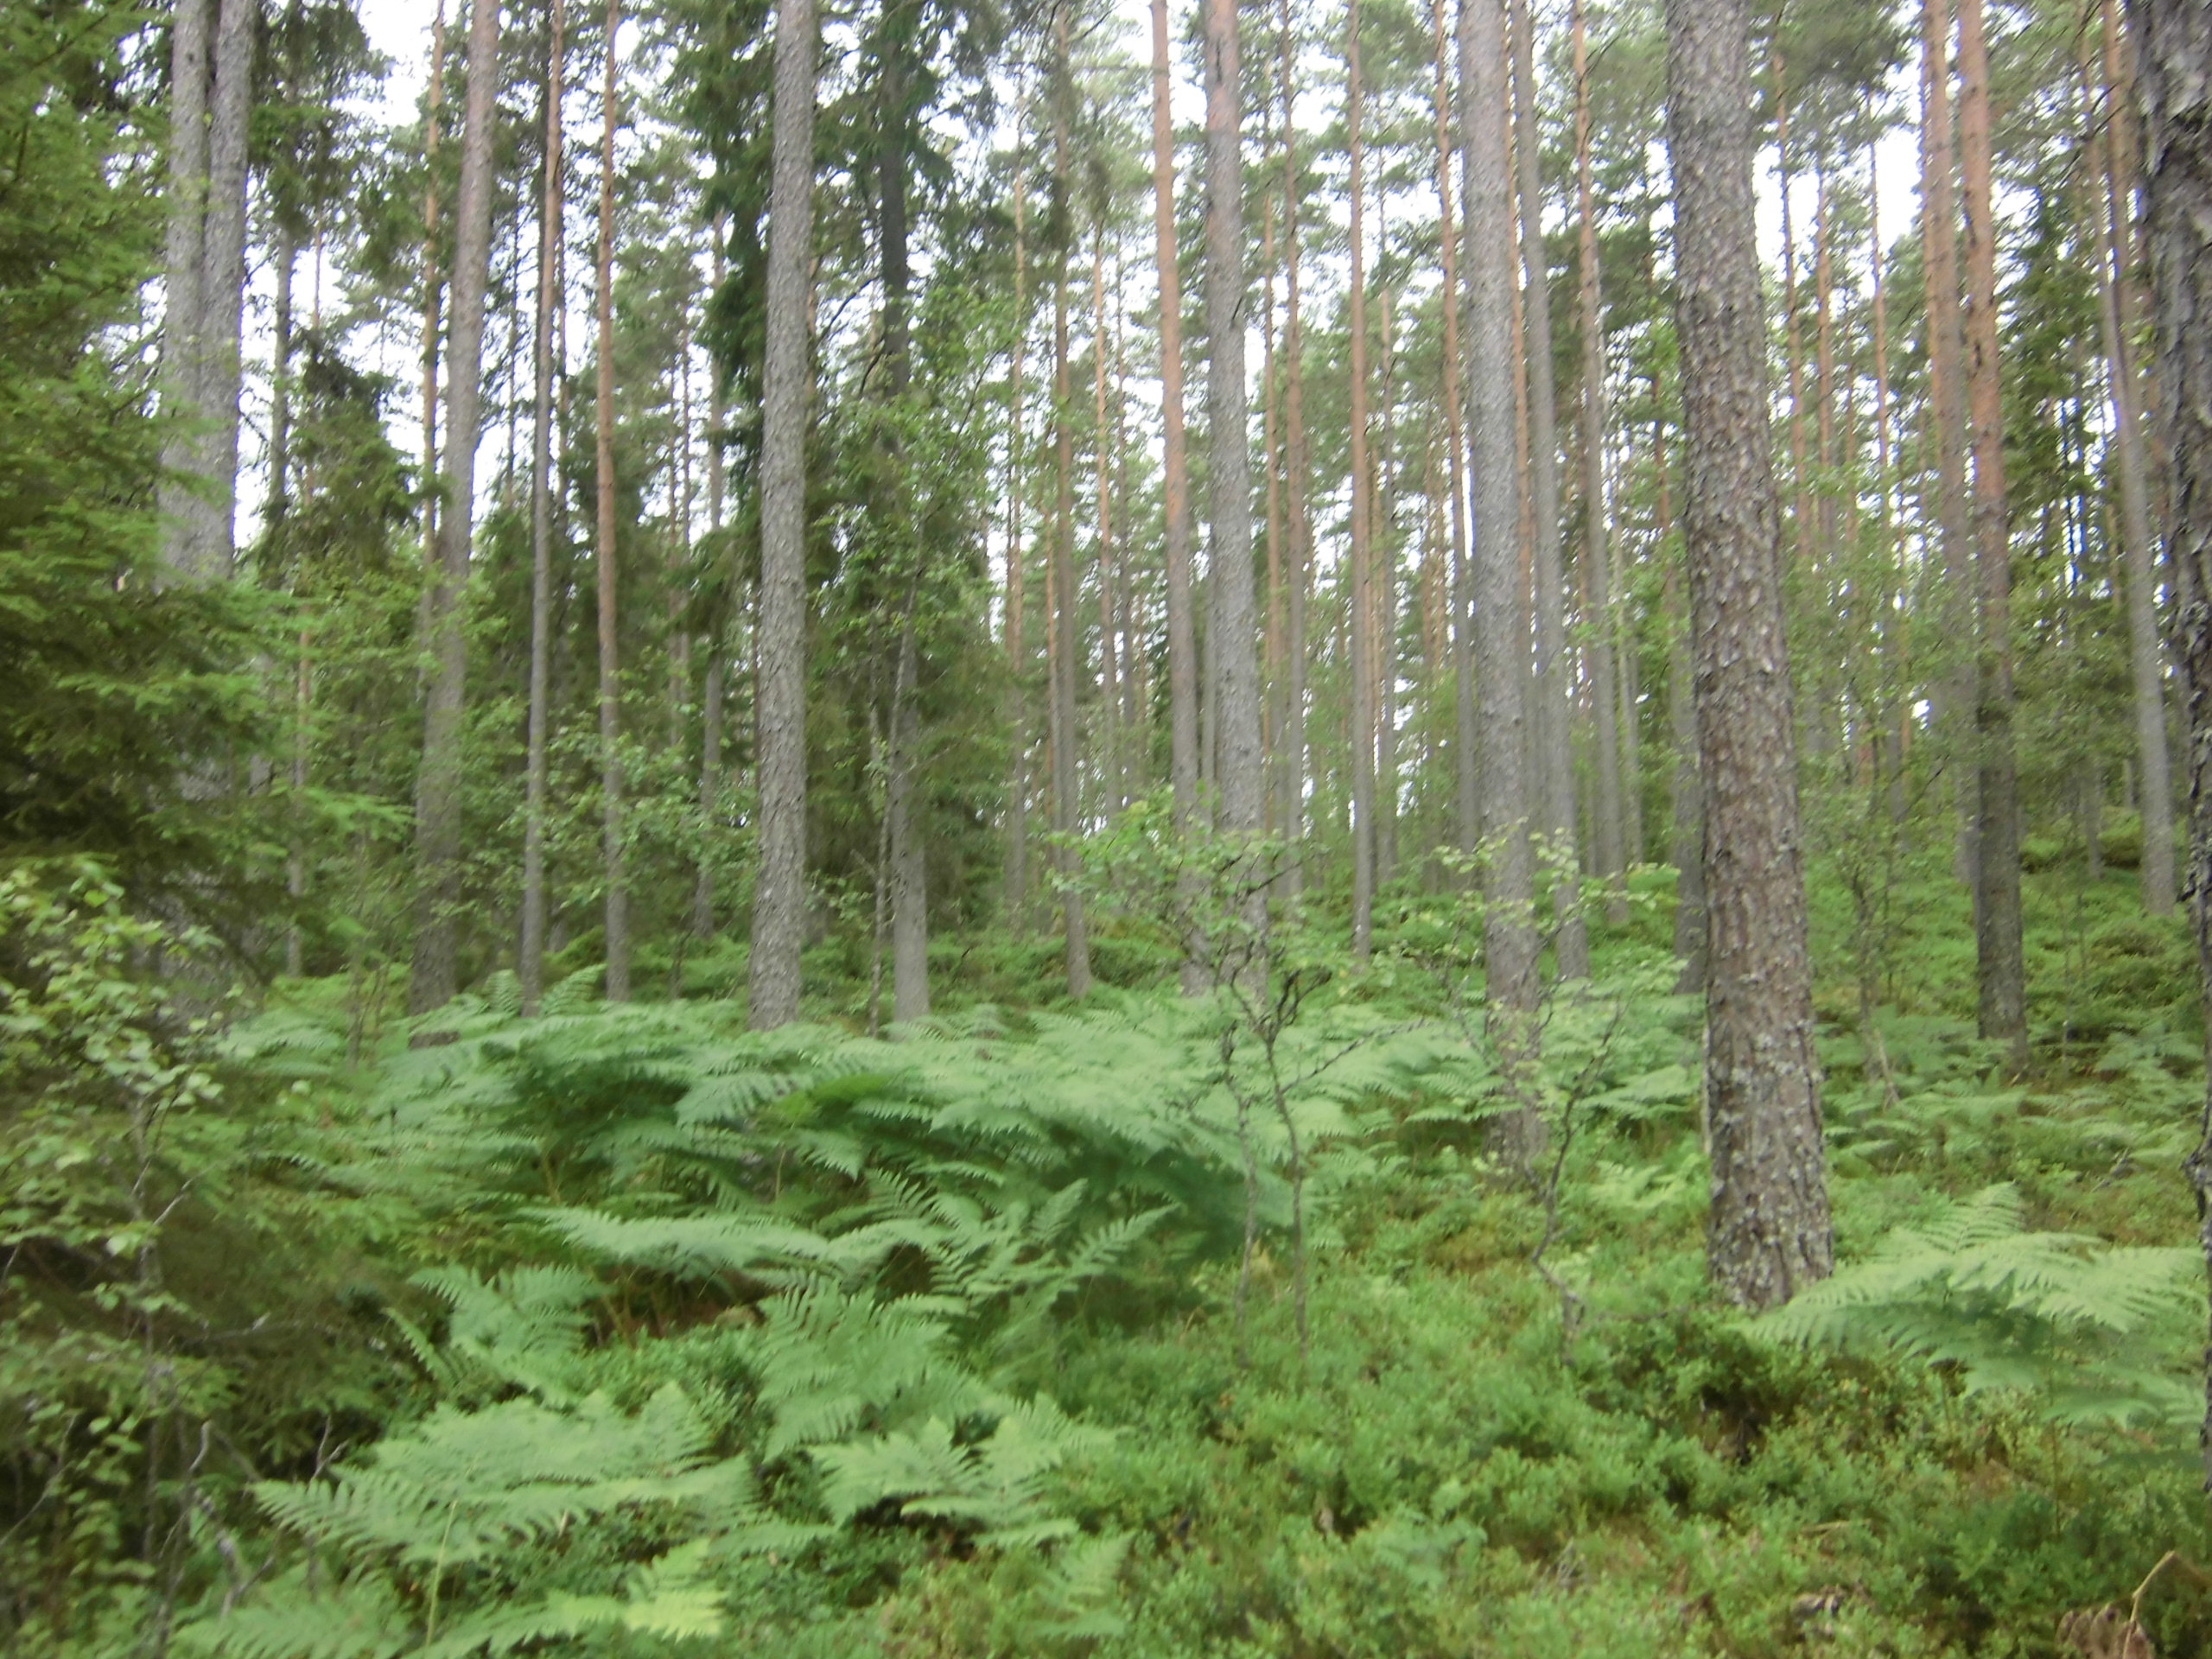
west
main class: Woodland
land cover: Pine dominated coniferous woodland
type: boreal forest
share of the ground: 50 - 75 %
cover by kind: coniferous forest trees 55 %, shrubs 30 %, broadleaved forest trees 5 %, herbaceous plants 5 %, lichens and mosses 5 %
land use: Forestry
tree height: > 5 m
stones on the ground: 25 - 50 %
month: July
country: SE
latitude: 57.2696
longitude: 15.2537
